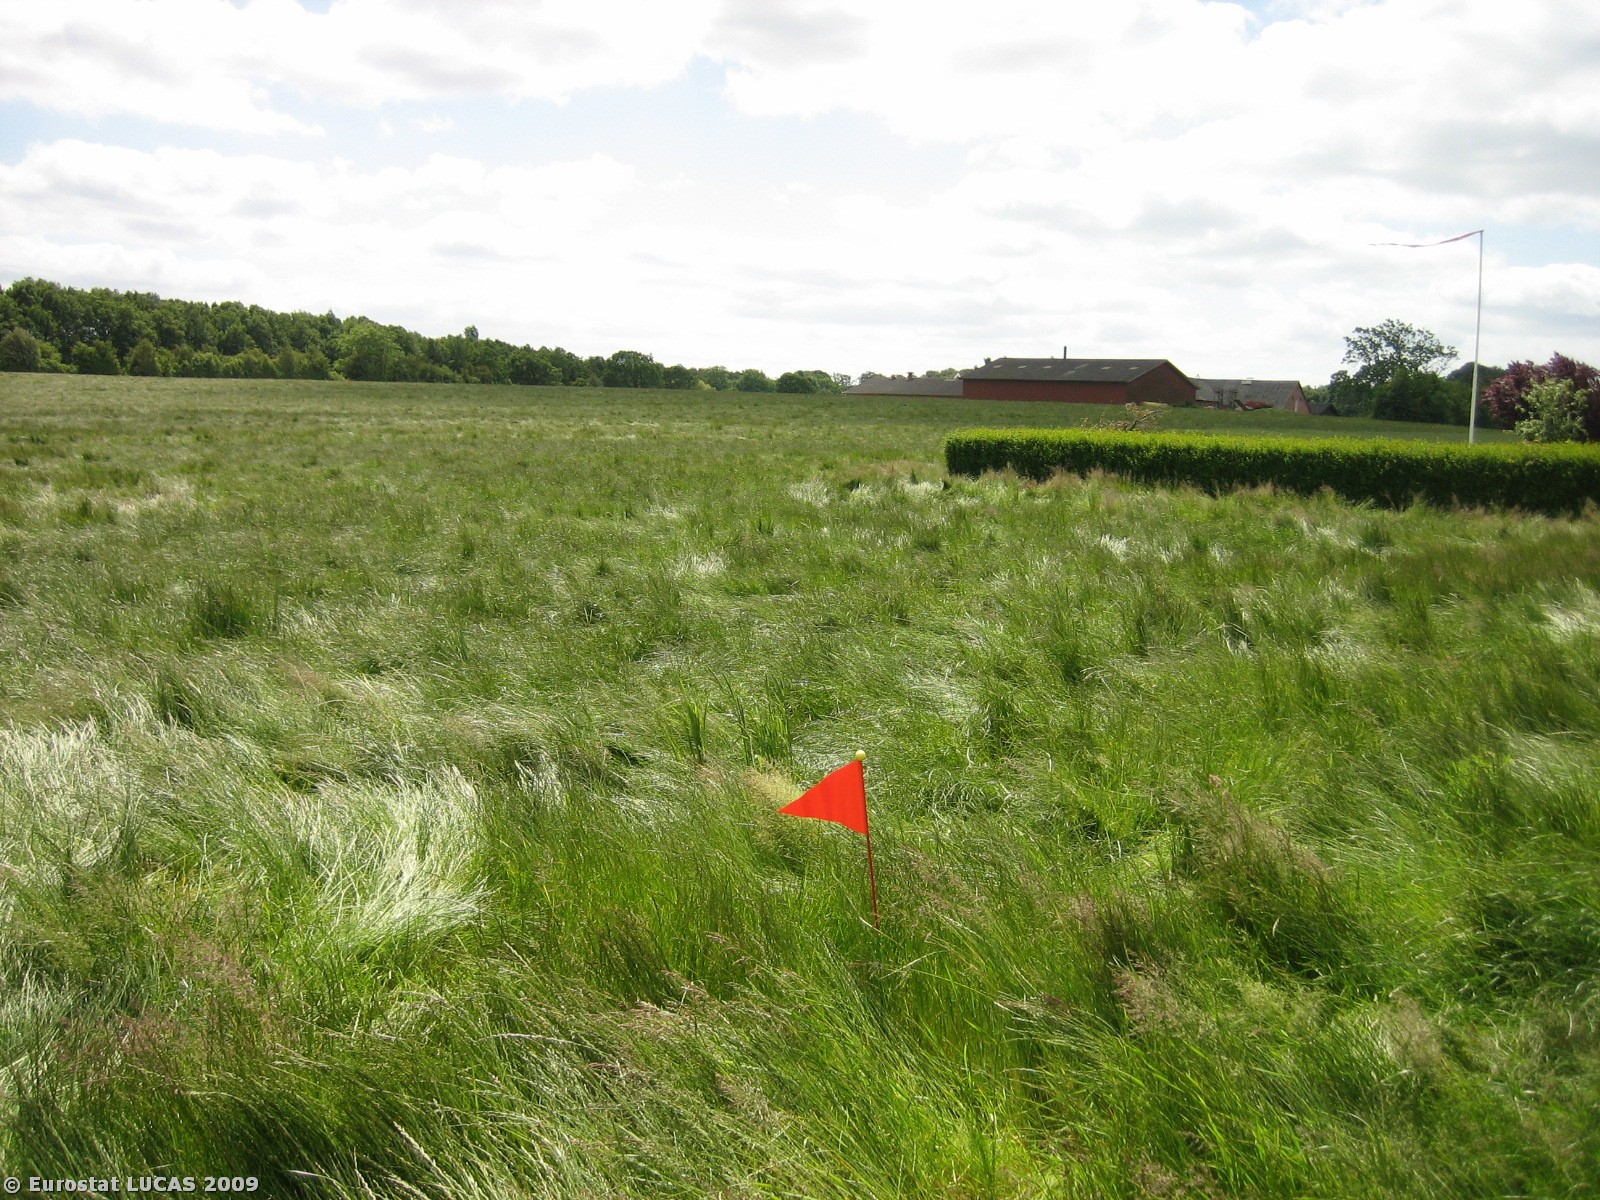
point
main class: Artificial land
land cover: Non built-up linear features
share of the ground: > 75 %
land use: Residential
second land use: Road transport
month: June
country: DK
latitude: 55.8279
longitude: 9.7289
